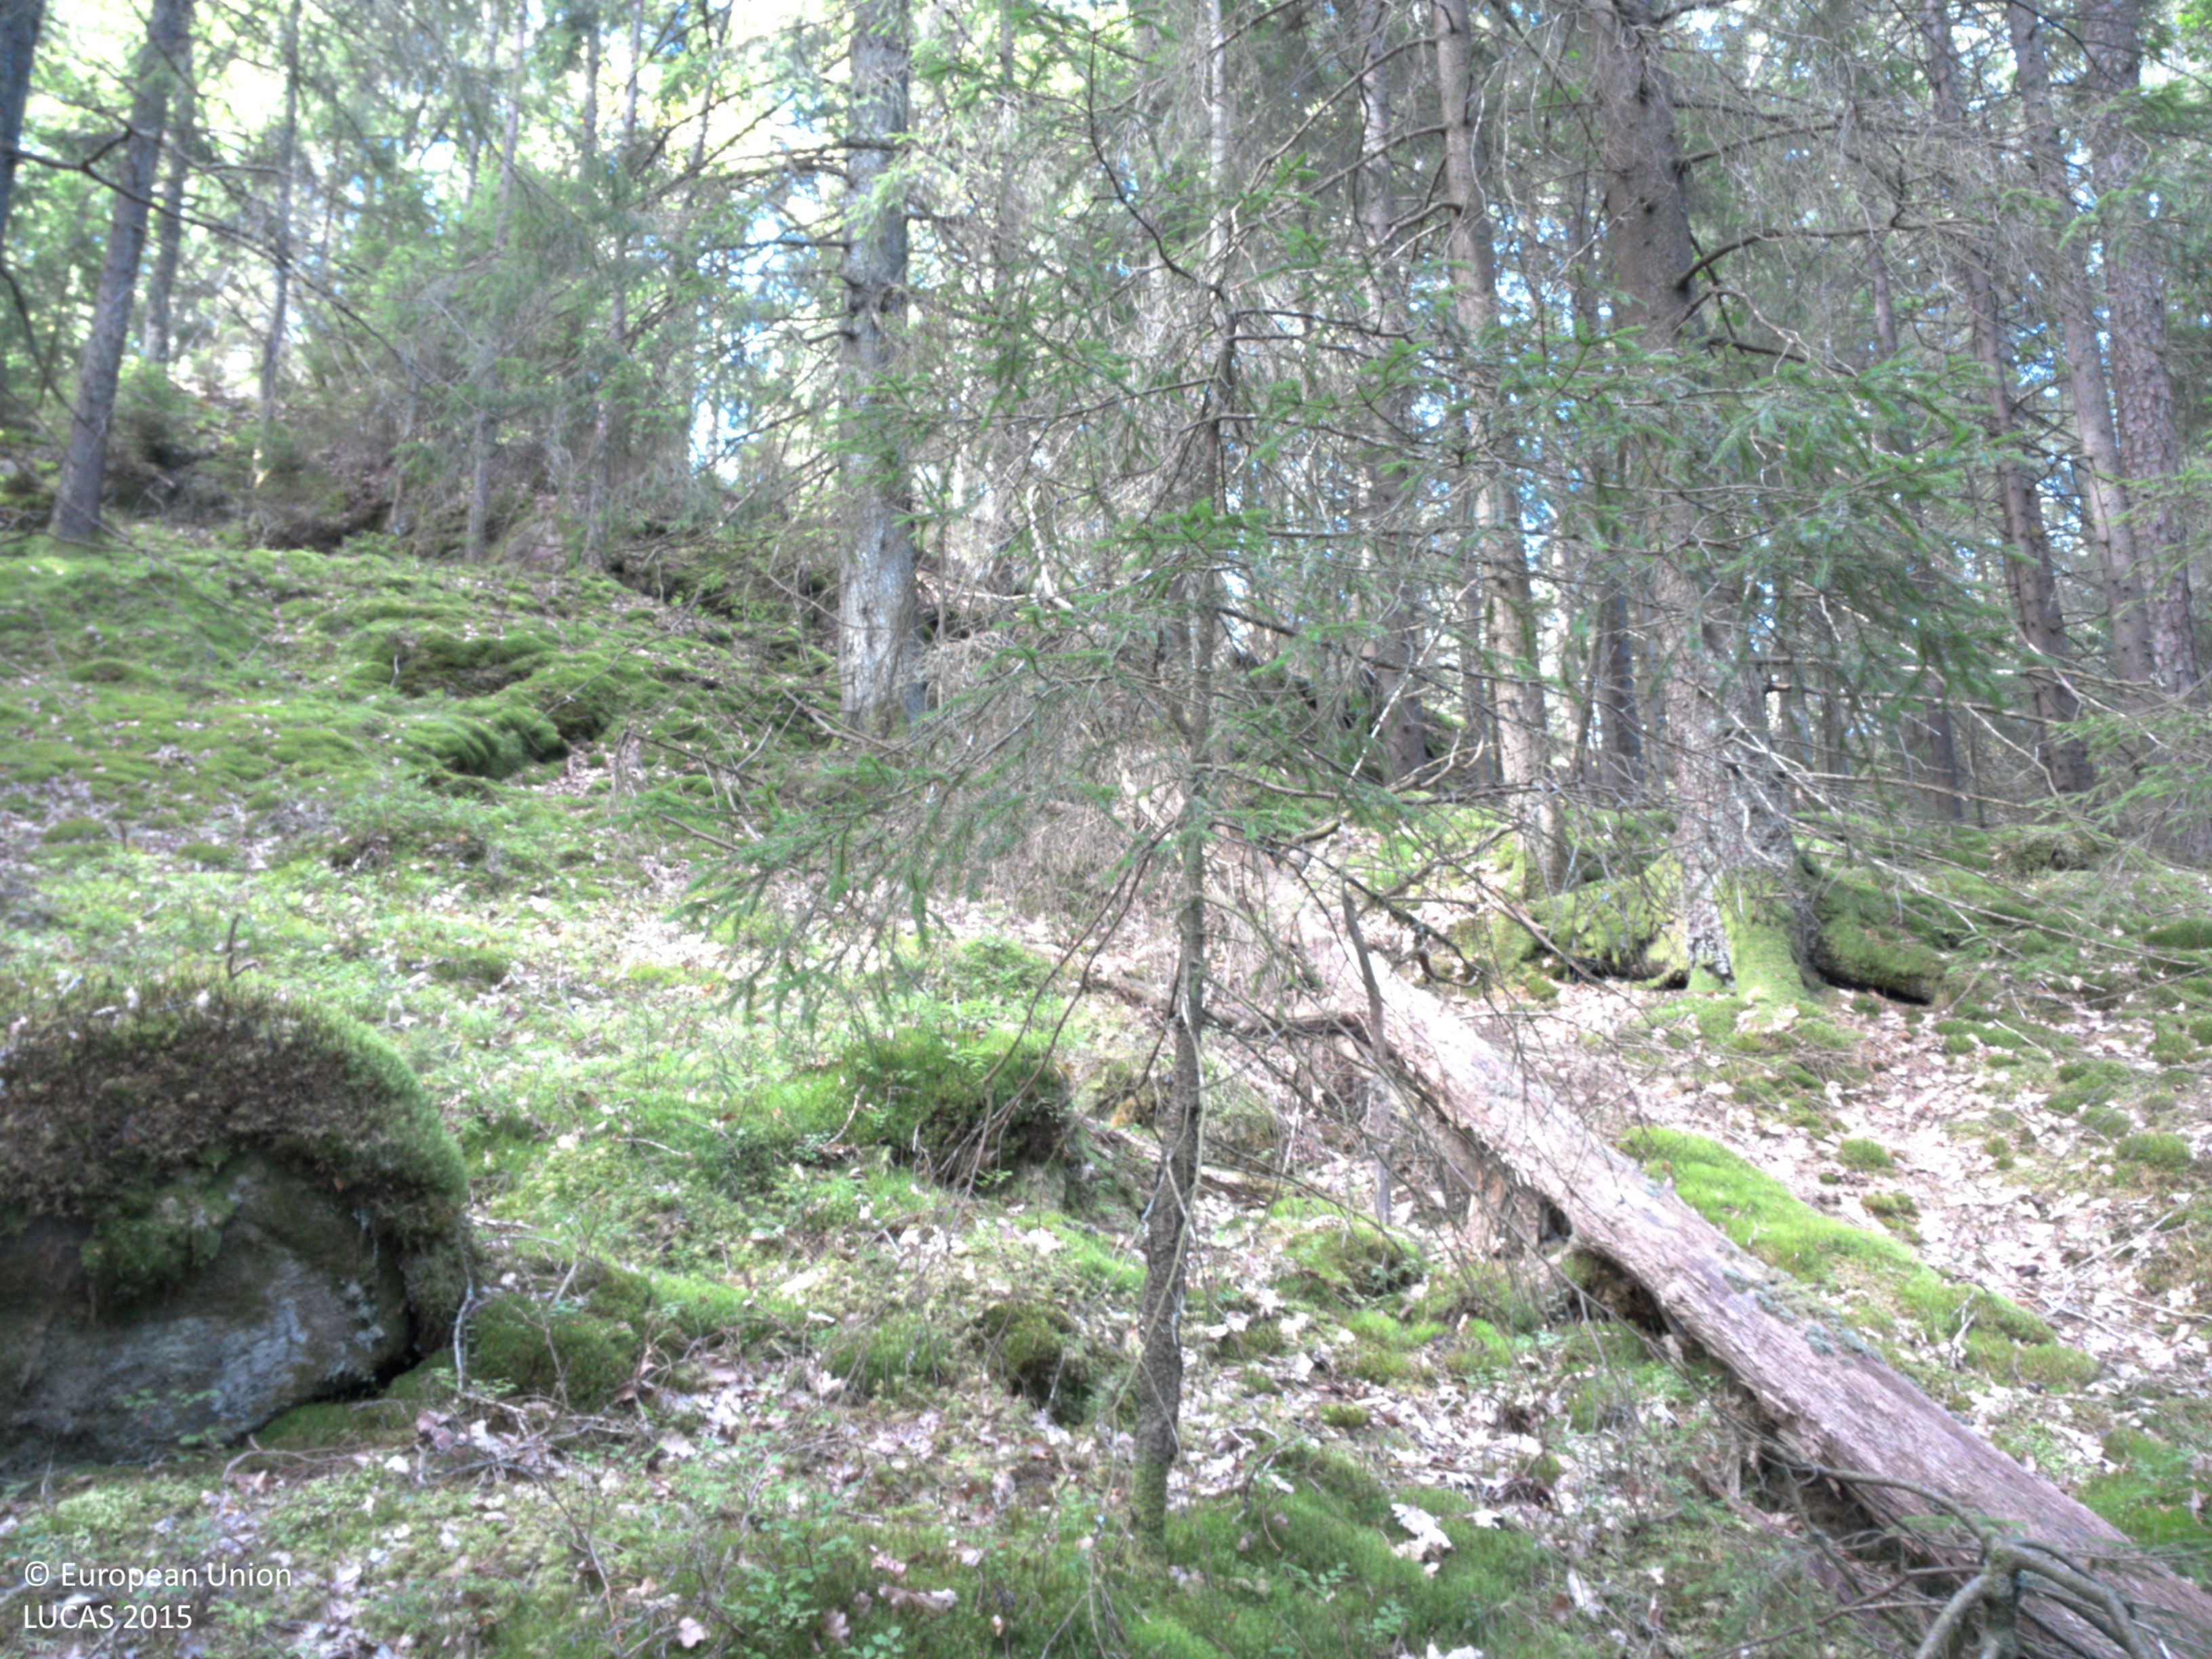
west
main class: Woodland
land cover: Spruce dominated coniferous woodland
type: boreal forest
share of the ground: 50 - 75 %
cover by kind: coniferous forest trees 60 %, herbaceous plants 25 %, shrubs 15 %
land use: Forestry
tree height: > 5 m
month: August
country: SE
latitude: 58.0430
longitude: 11.9783
